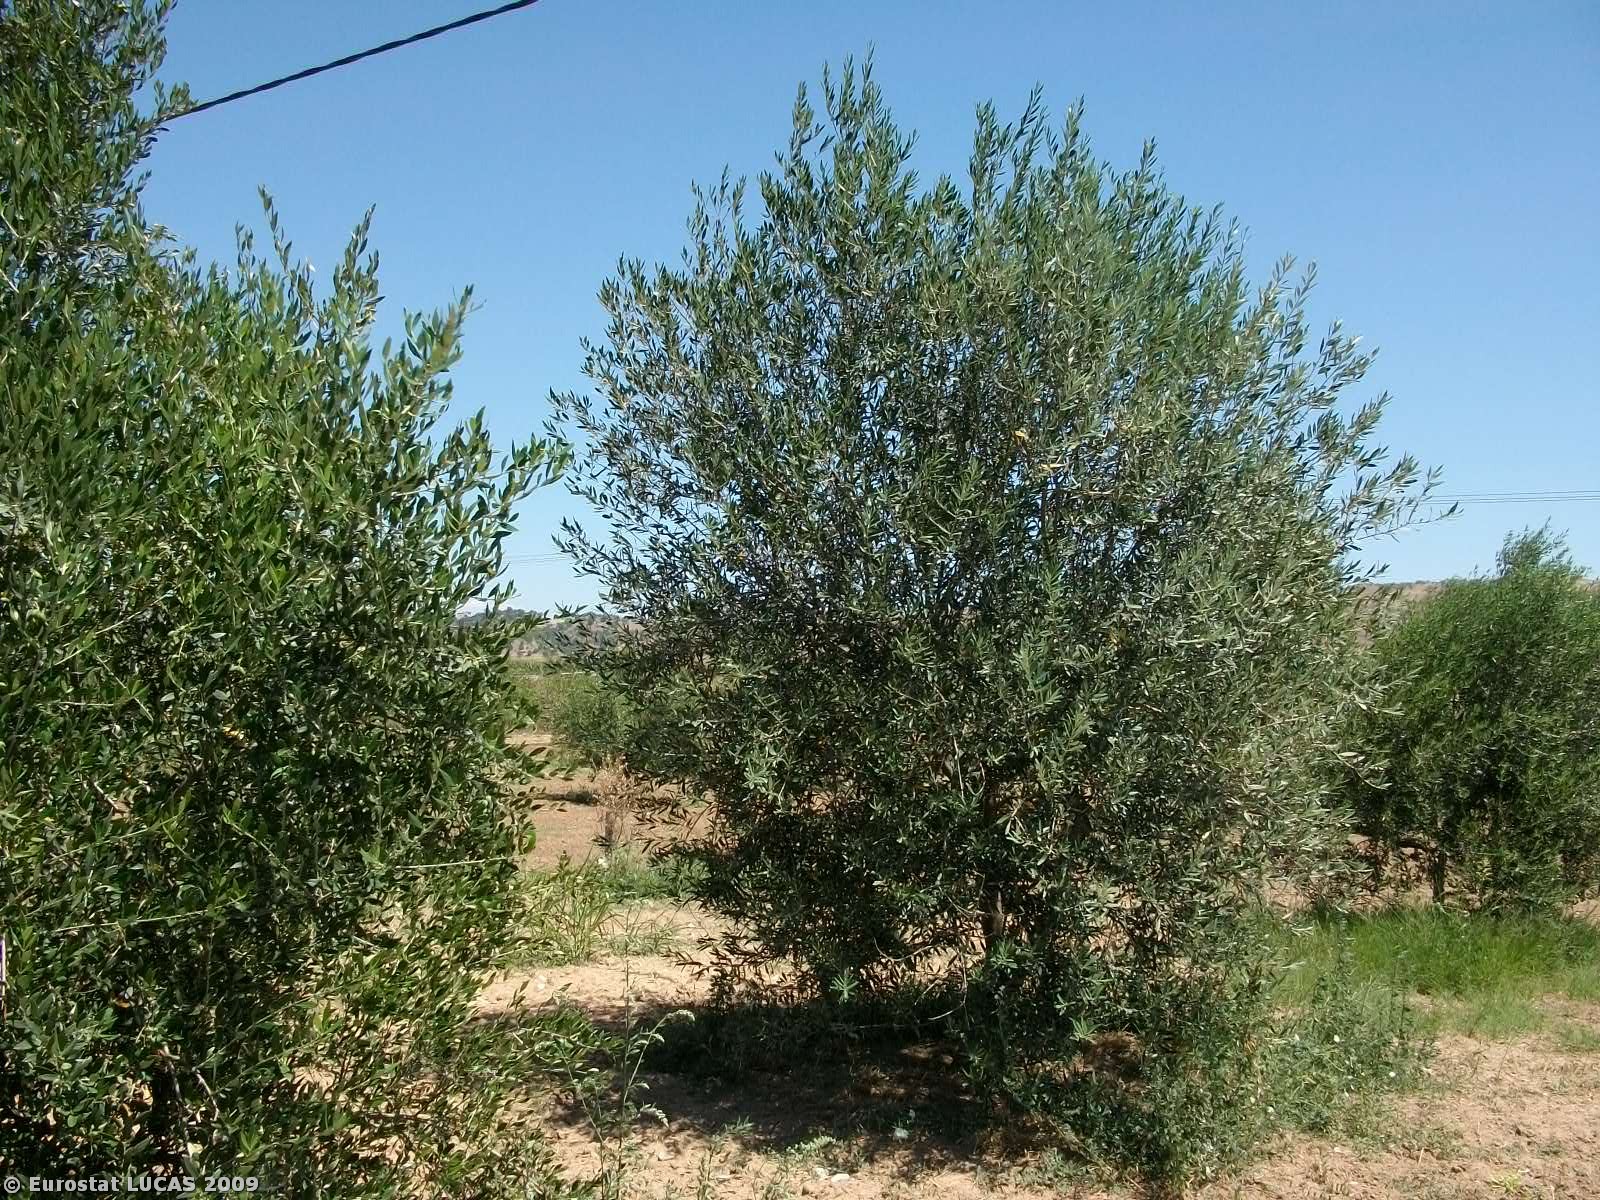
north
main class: Cropland
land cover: Maize
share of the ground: > 75 %
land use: Agriculture (excluding fallow land and kitchen gardens)
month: July
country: GR
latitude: 39.6385
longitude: 21.6941
